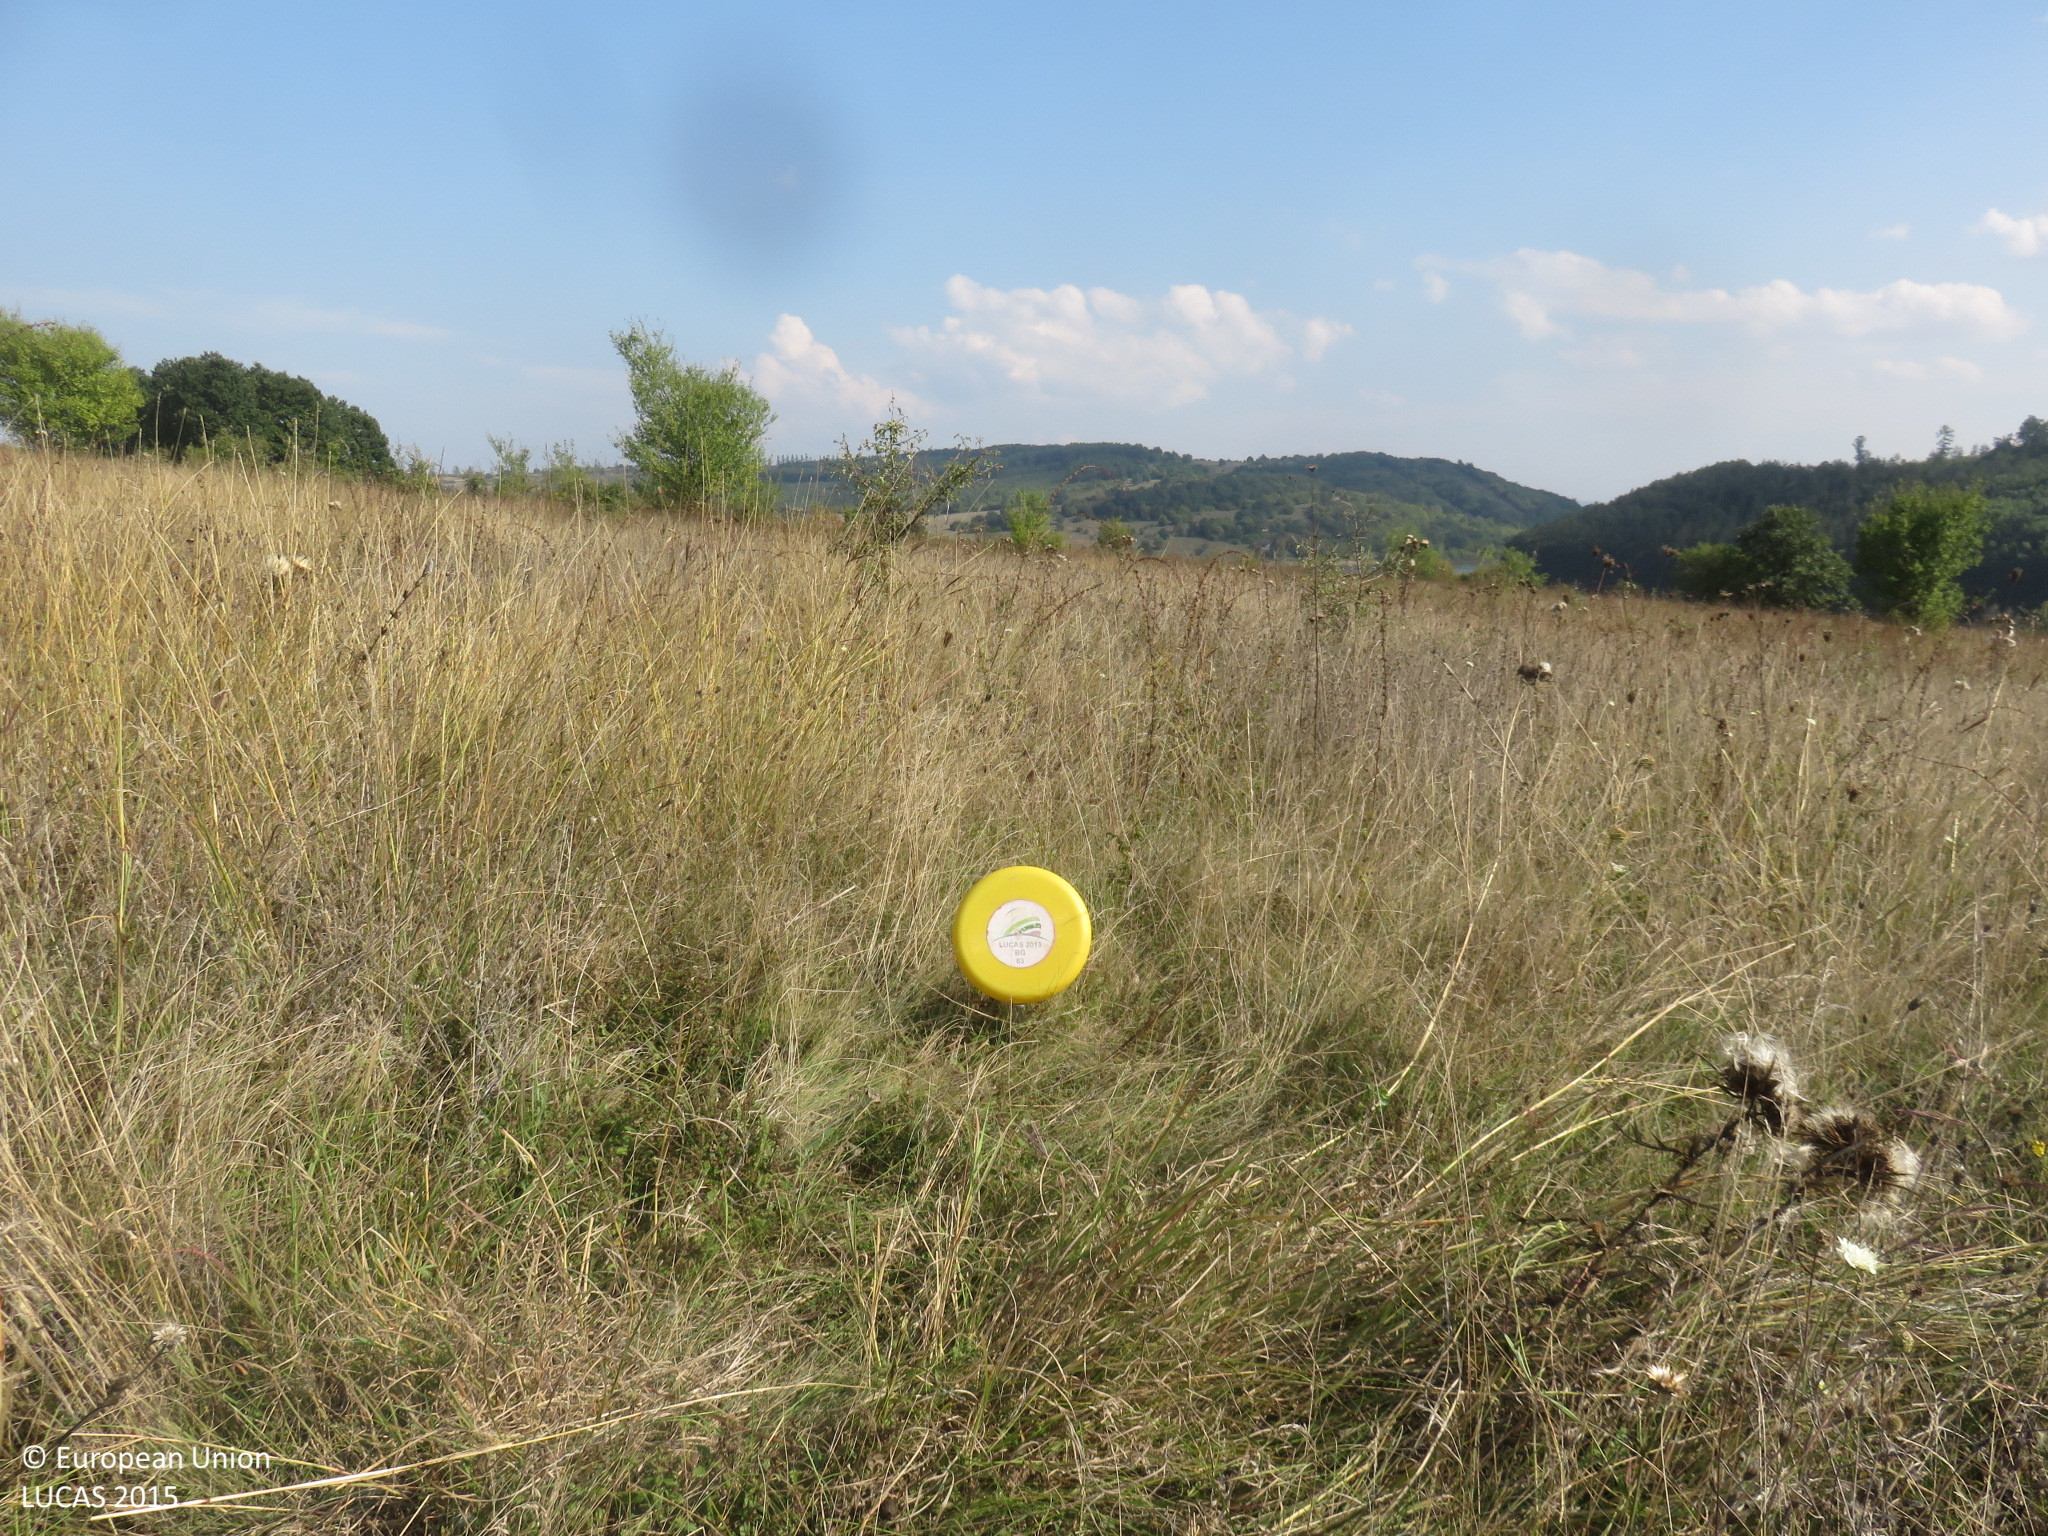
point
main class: Grassland
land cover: Grassland with sparse tree/shrub cover
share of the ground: > 75 %
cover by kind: herbaceous plants 90 %, broadleaved forest trees 5 %, shrubs 5 %
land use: Fallow land
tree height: < 5 m
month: September
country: BG
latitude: 43.1561
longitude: 25.0348
